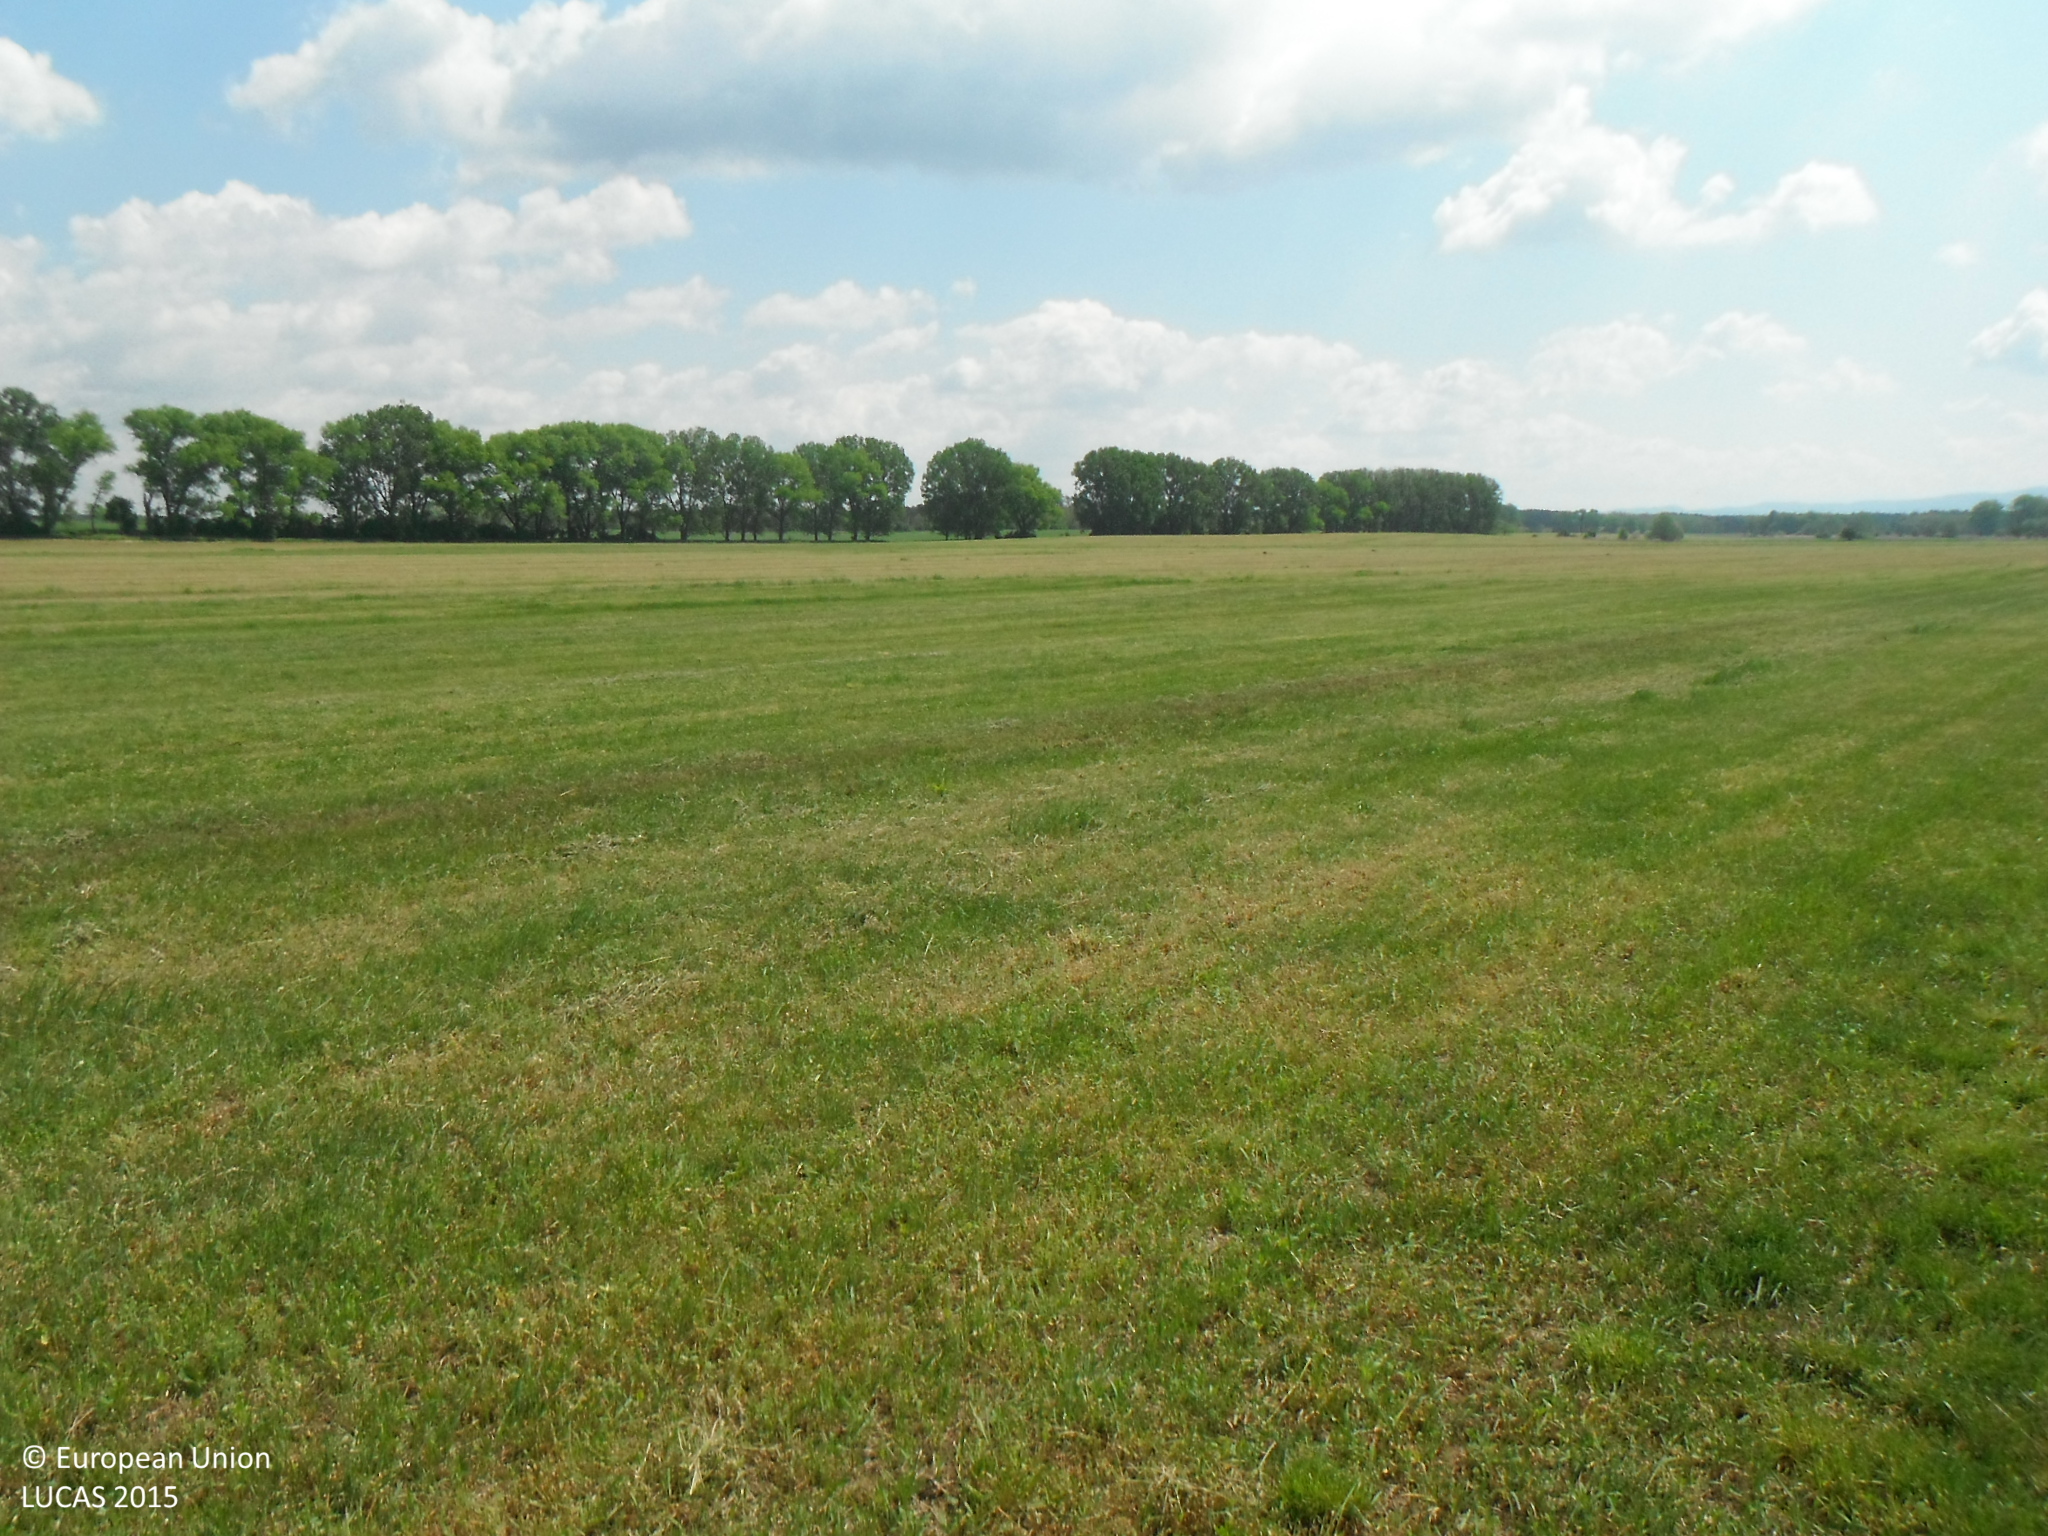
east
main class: Grassland
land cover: Grassland without tree/shrub cover
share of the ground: > 75 %
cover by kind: herbaceous plants 100 %
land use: Agriculture (excluding fallow land and kitchen gardens)
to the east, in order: Grassland without tree/shrub cover
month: May
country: SK
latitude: 48.5582
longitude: 17.0405
